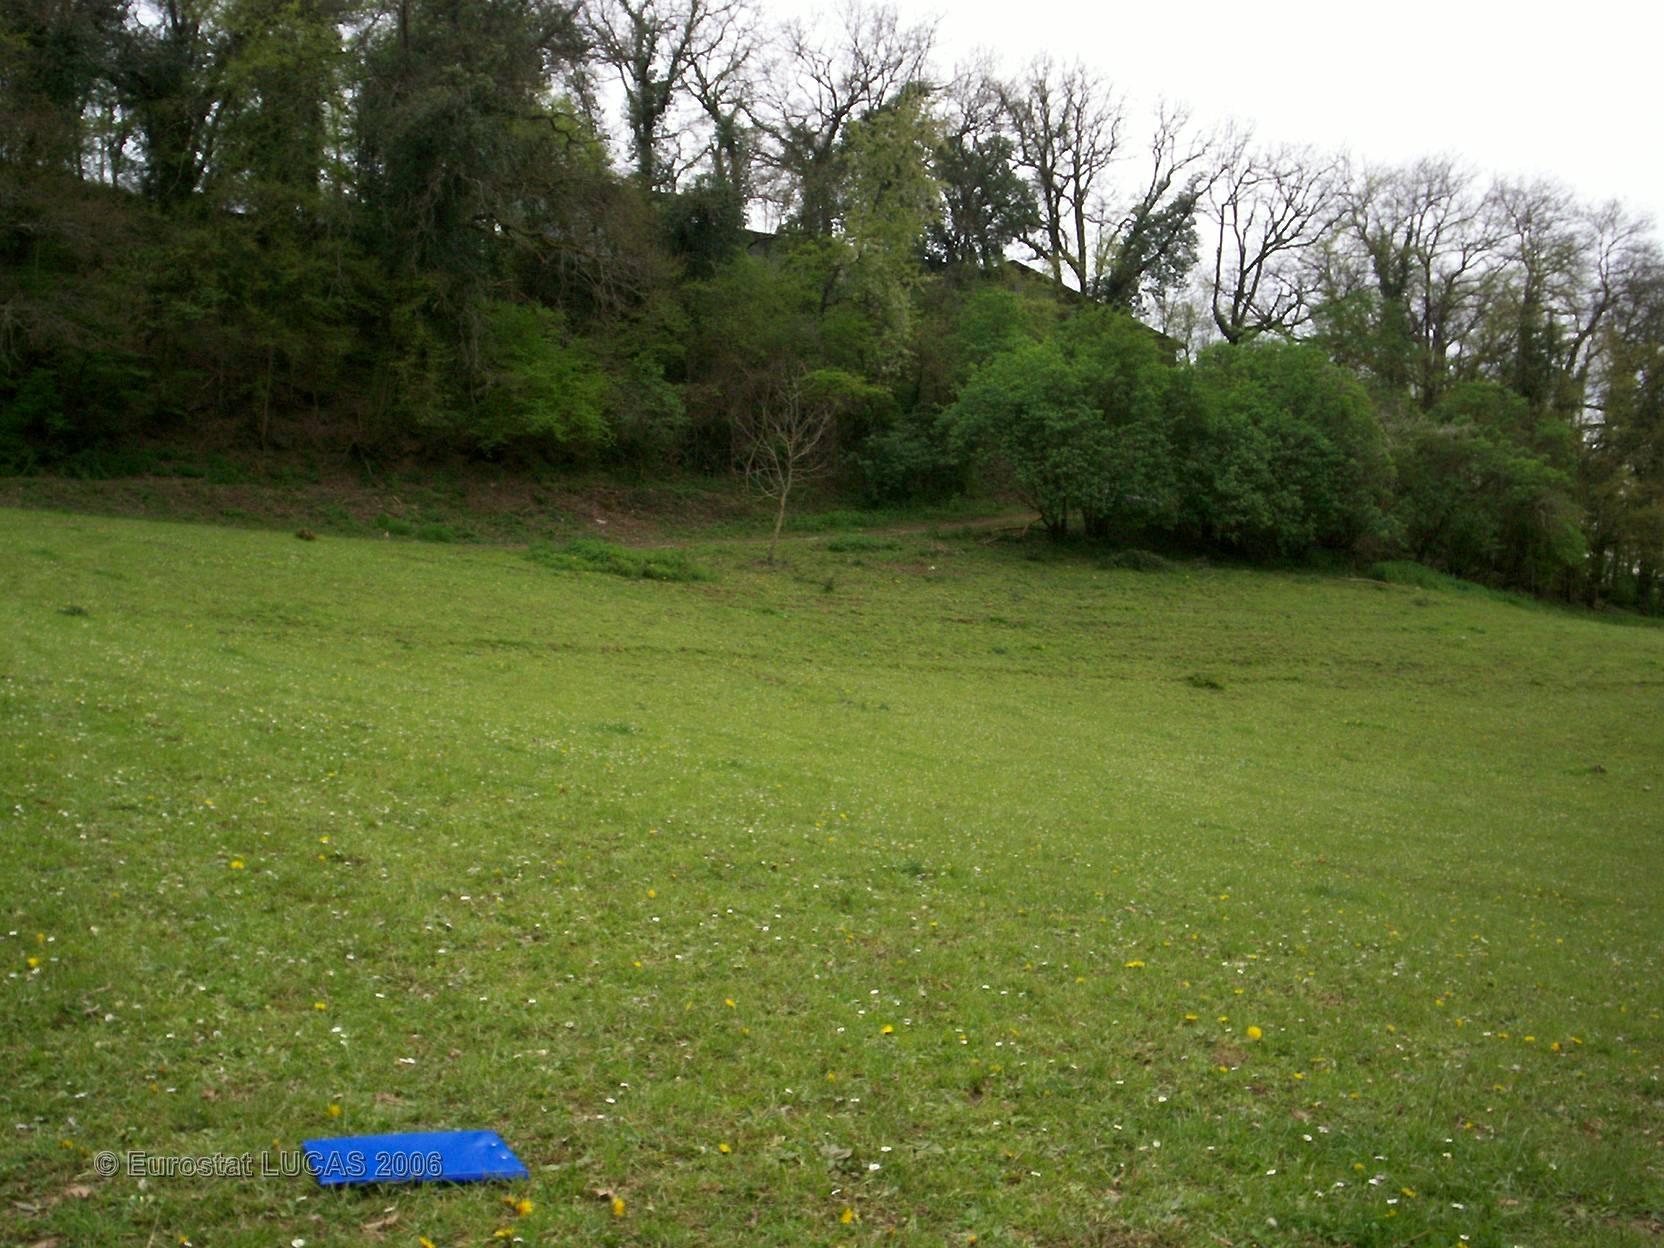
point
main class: Grassland
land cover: Grassland without tree/shrub cover
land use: Agriculture (excluding fallow land and kitchen gardens)
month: April
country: FR
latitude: 43.6757
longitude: 0.2836
